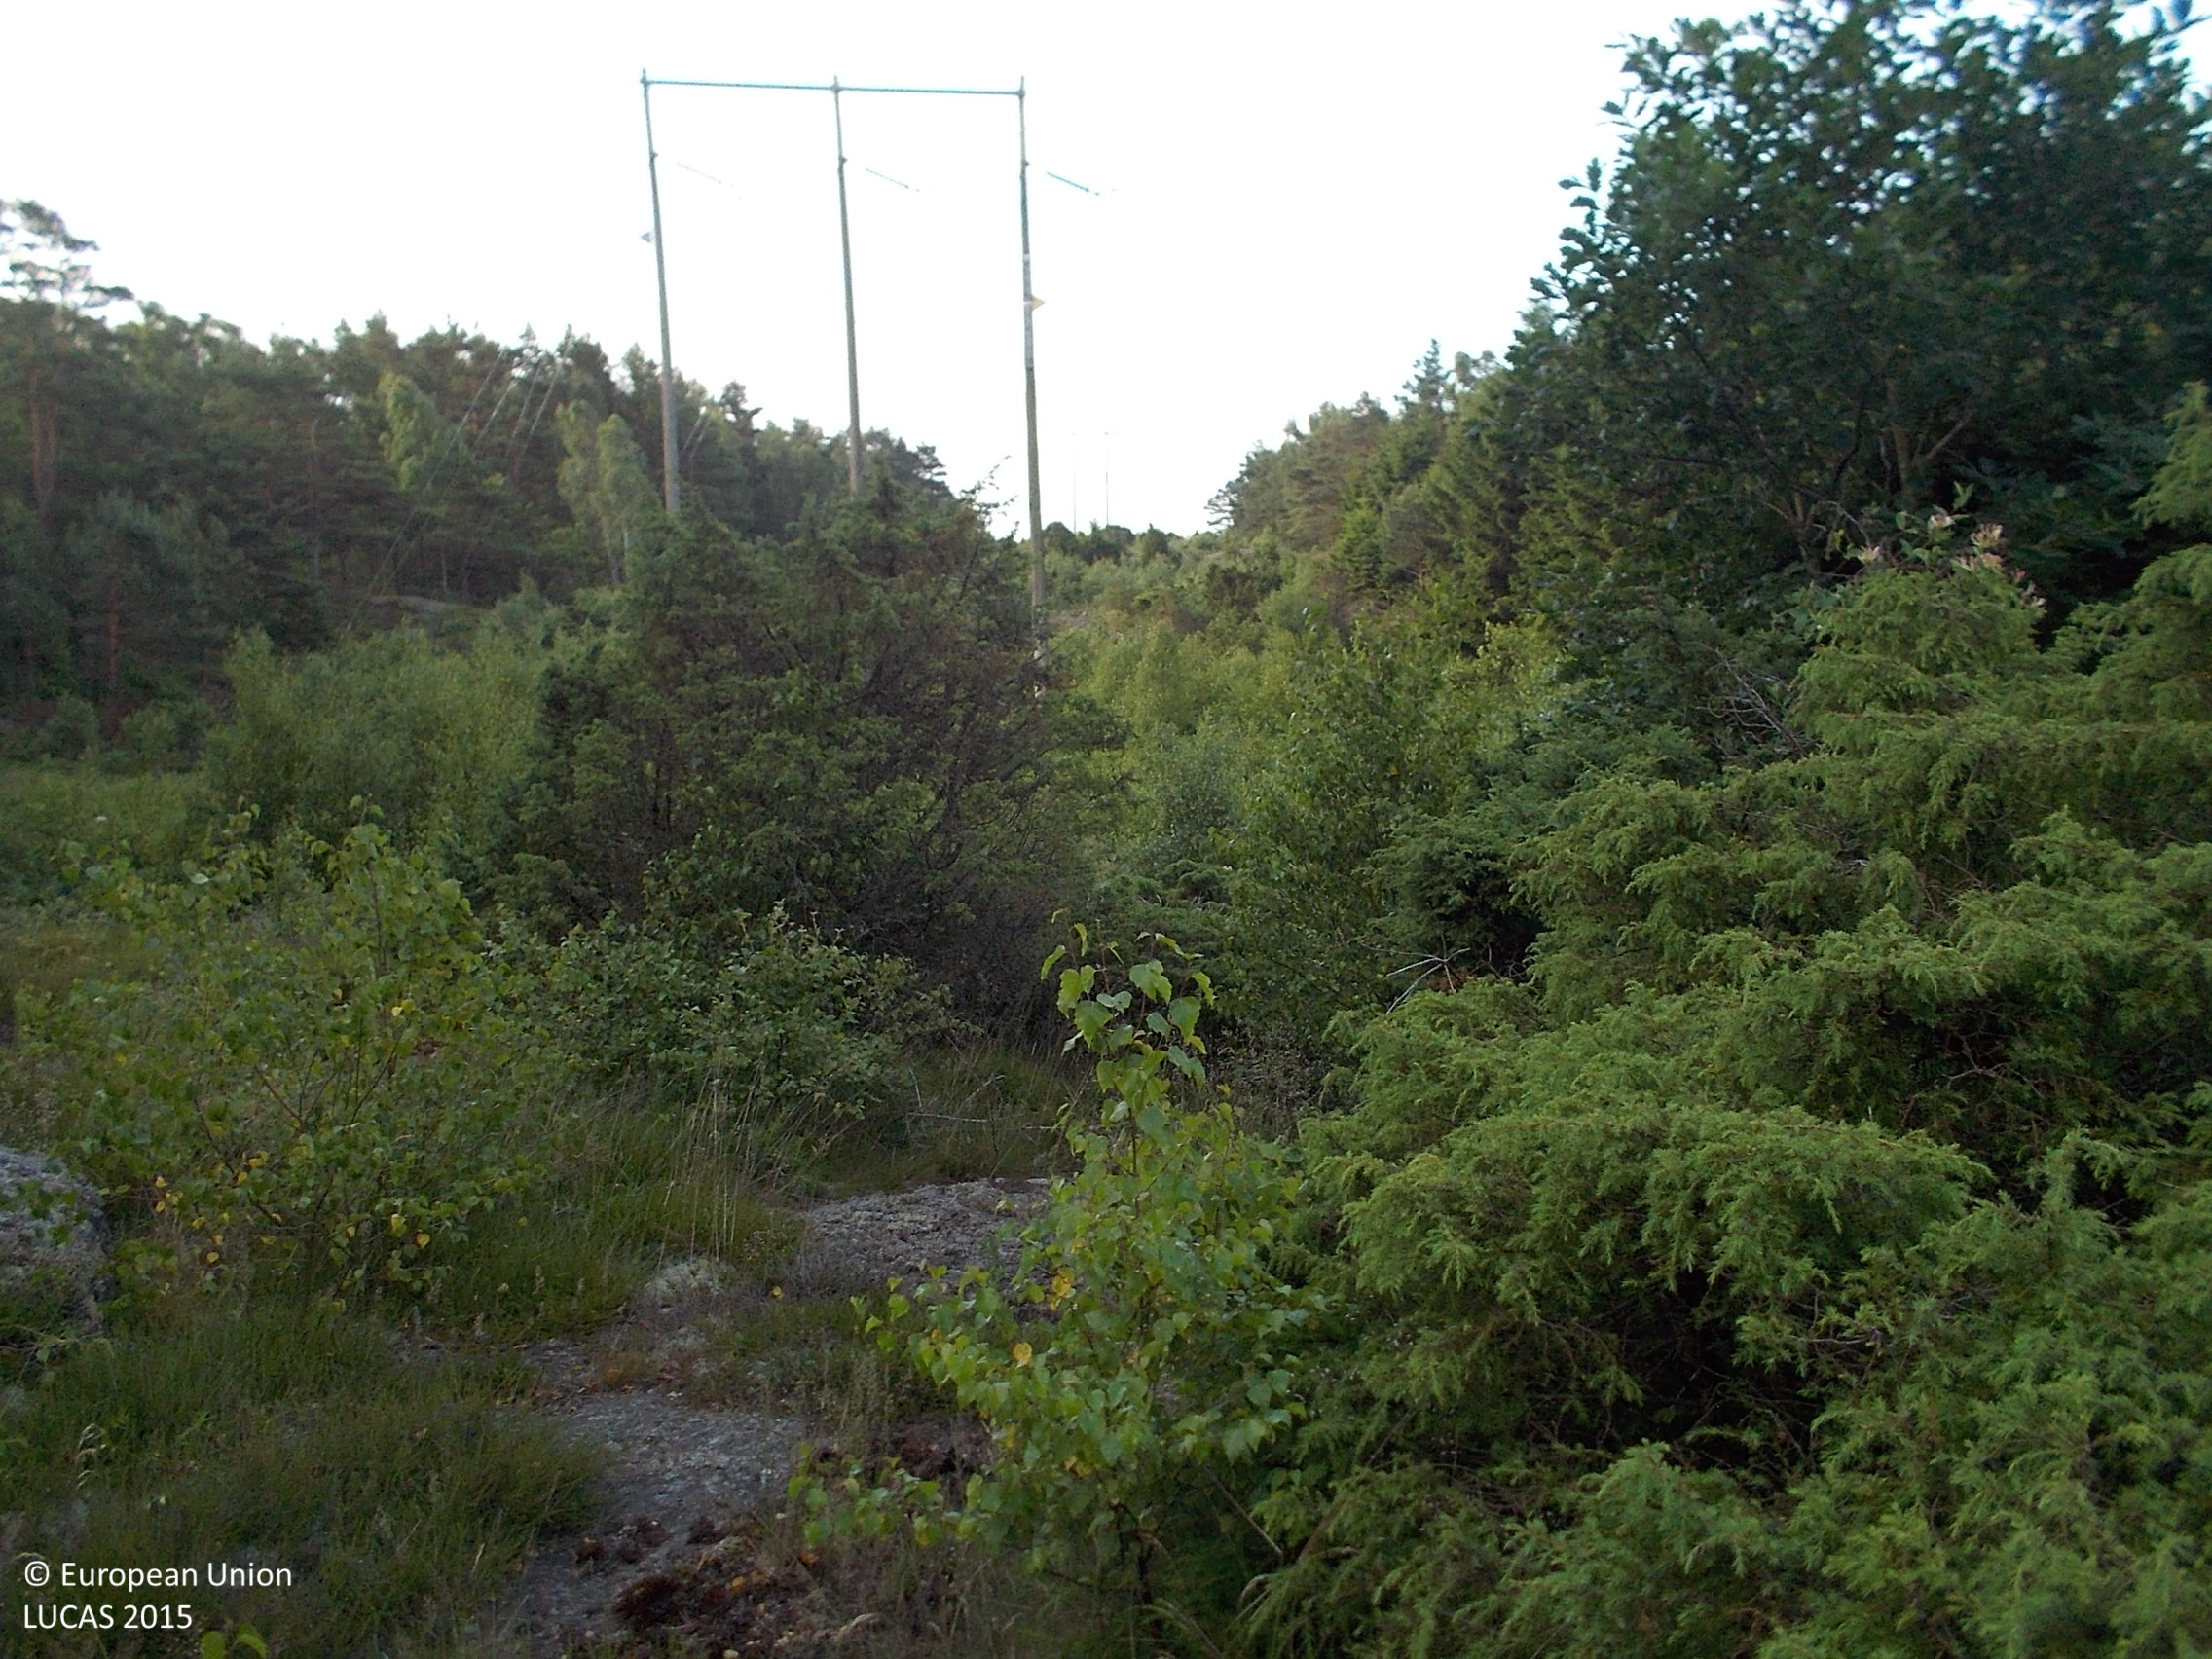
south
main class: Shrubland
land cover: Shrubland with sparse tree cover
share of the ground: > 75 %
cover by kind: shrubs 70 %, herbaceous plants 10 %, lichens and mosses 10 %, broadleaved forest trees 5 %, consolidated bare surface 5 %
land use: Electricity, gas and thermal power distribution
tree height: < 5 m
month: July
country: SE
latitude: 57.1930
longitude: 12.2639
